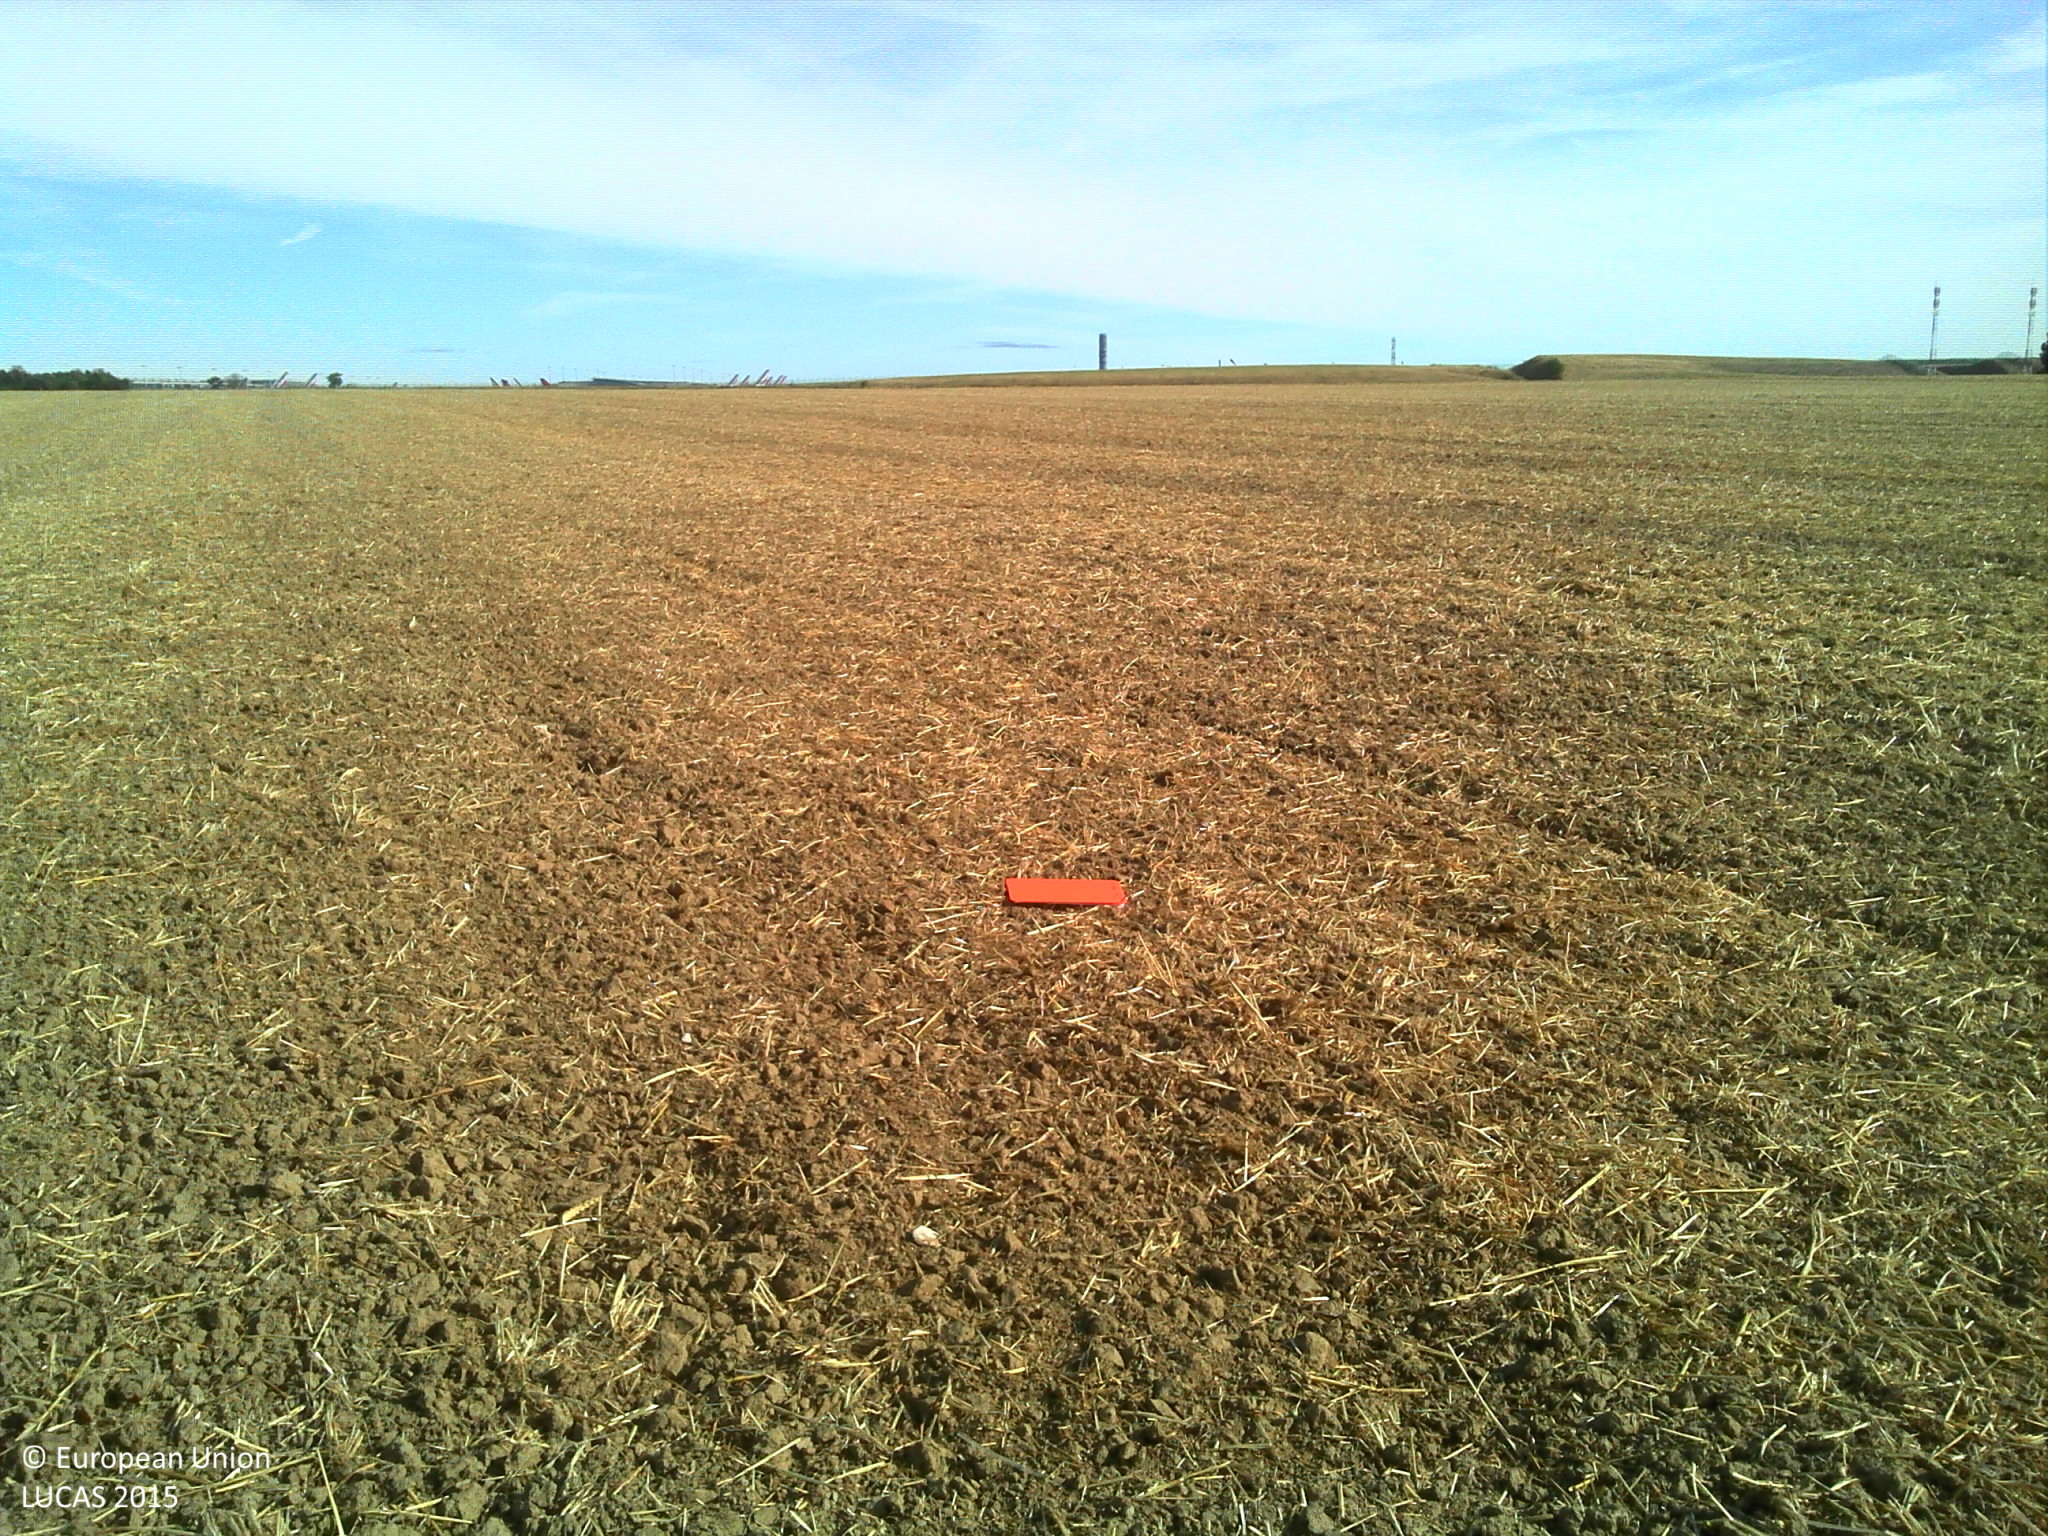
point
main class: Cropland
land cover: Common wheat
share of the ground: > 75 %
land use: Agriculture (excluding fallow land and kitchen gardens)
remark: Harvested field
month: August
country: FR
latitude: 48.9862
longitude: 2.5963
